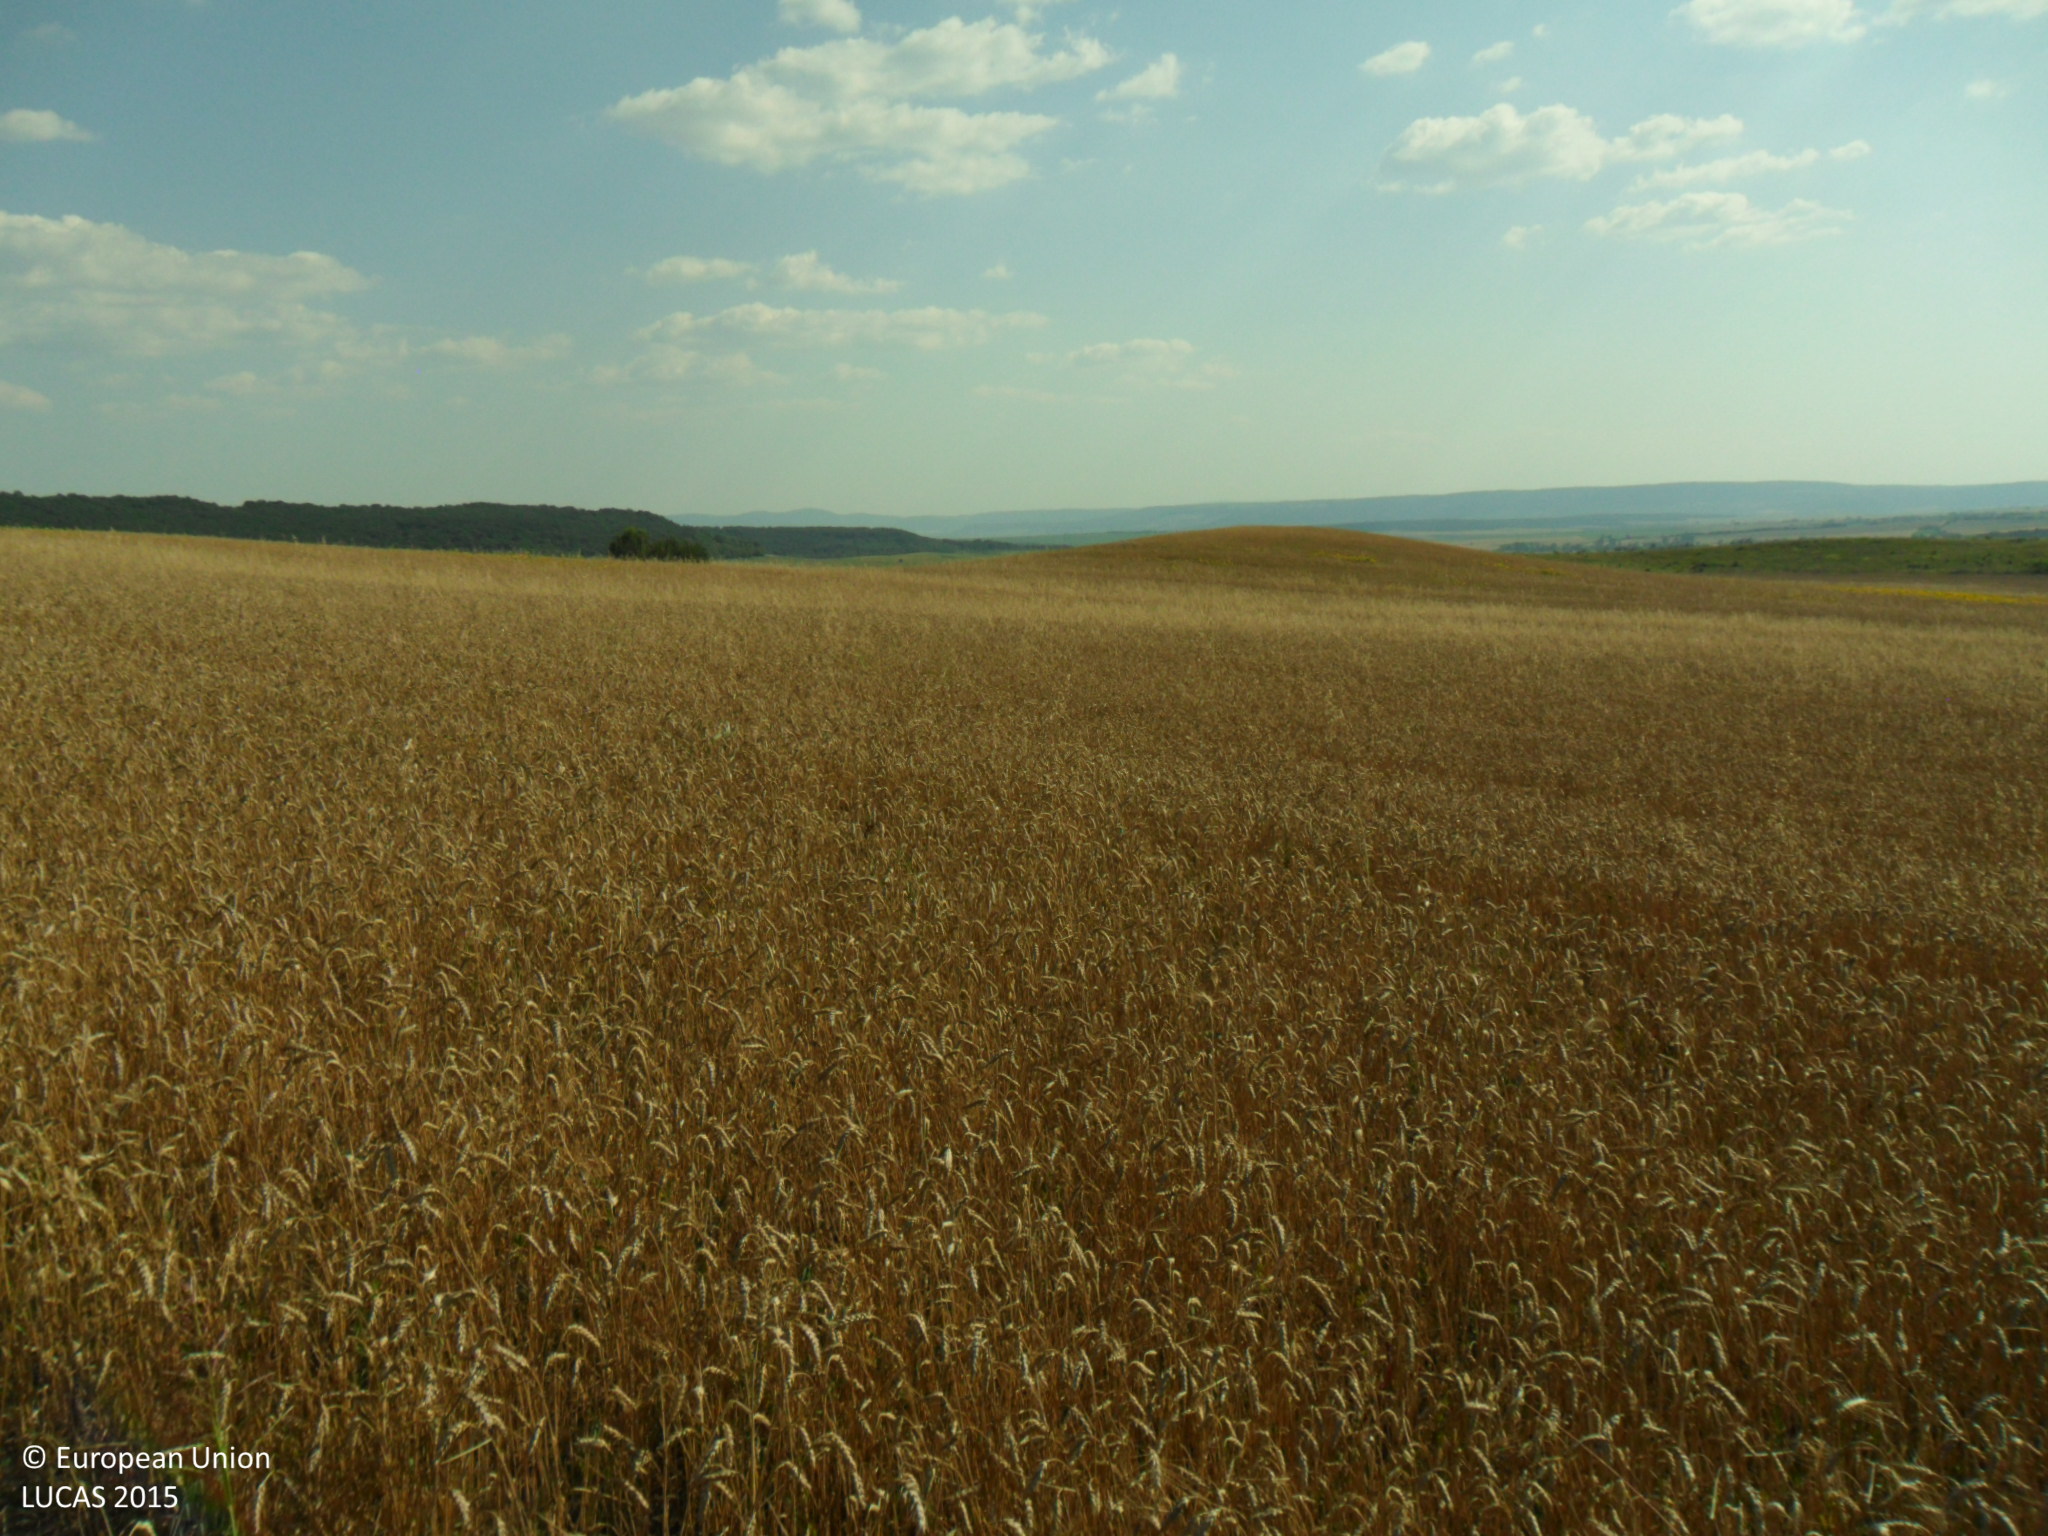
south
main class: Cropland
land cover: Common wheat
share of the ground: > 75 %
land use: Agriculture (excluding fallow land and kitchen gardens)
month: July
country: BG
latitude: 43.3945
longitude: 26.5621
